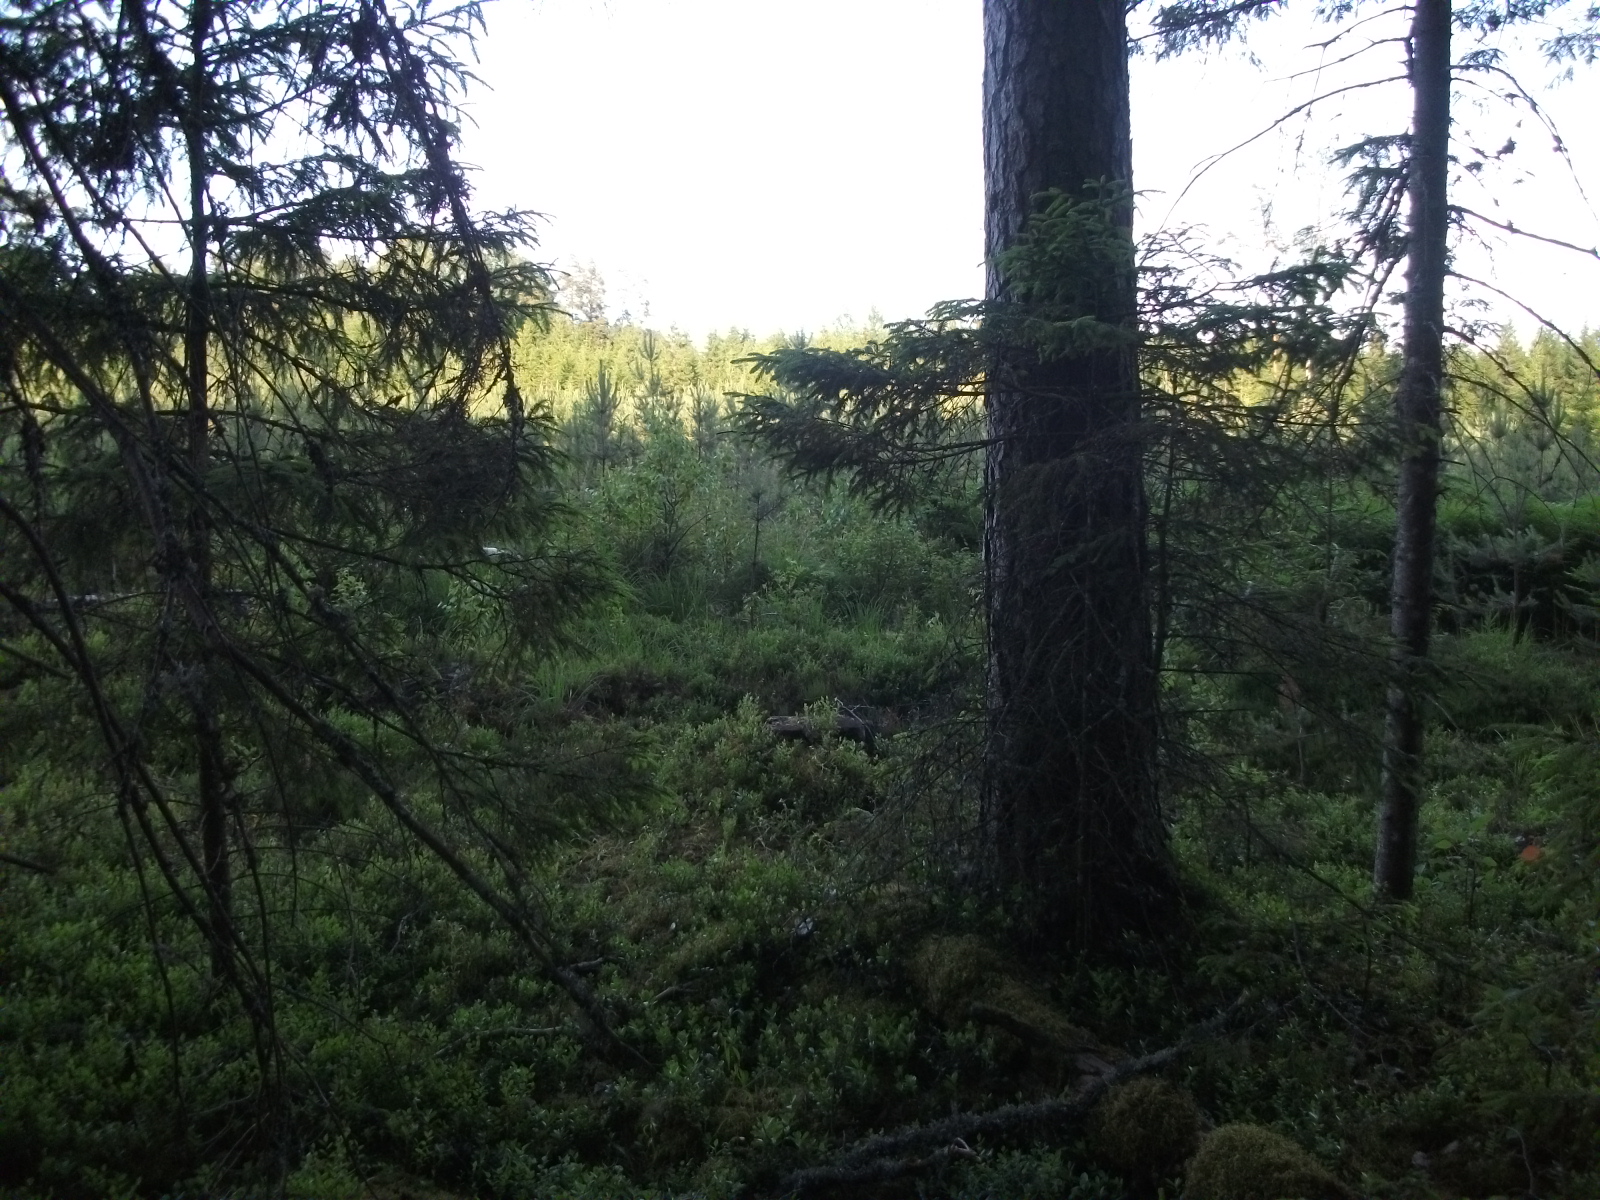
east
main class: Woodland
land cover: Other coniferous woodland
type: hemiboreal forest and nemoral coniferous forest and mixed broadleaved-coniferous forest
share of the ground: > 75 %
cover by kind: coniferous forest trees 80 %, broadleaved forest trees 5 %, shrubs 5 %, herbaceous plants 5 %, lichens and mosses 5 %
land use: Forestry
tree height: > 5 m
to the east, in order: Other coniferous woodland; Spontaneously vegetated surfaces; Pine dominated mixed woodland; Spruce dominated coniferous woodland; Other structural elements; Spruce dominated coniferous woodland
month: June
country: LV
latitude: 56.9230
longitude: 26.5598
